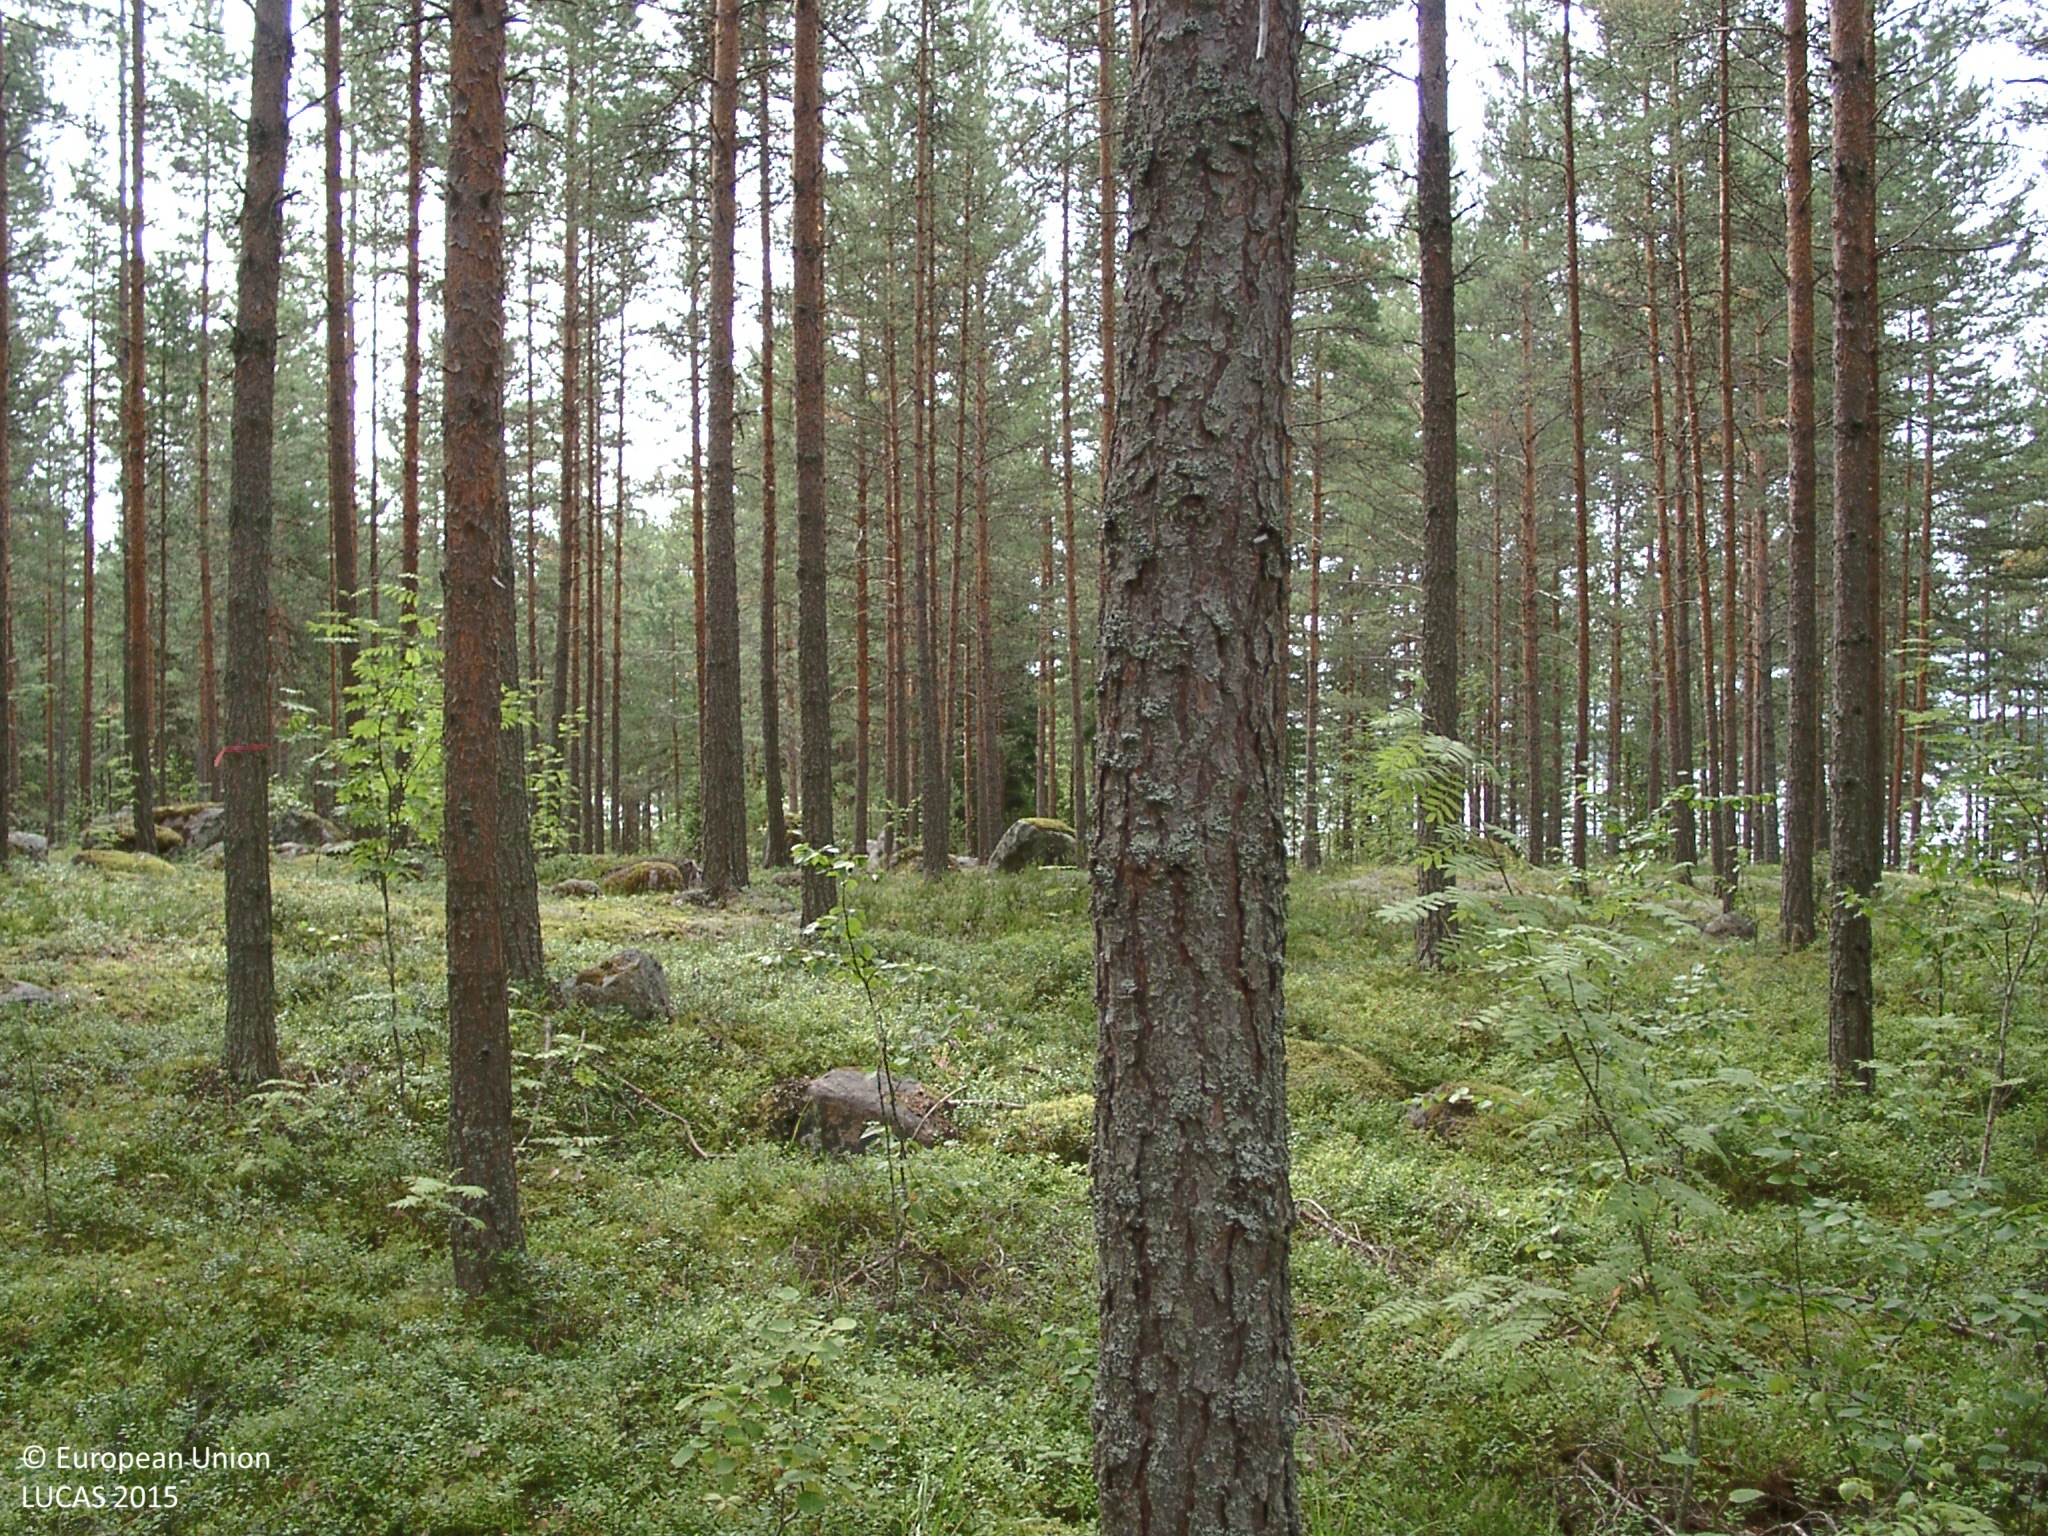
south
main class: Woodland
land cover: Pine dominated coniferous woodland
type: boreal forest
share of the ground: 50 - 75 %
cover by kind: coniferous forest trees 65 %, shrubs 20 %, lichens and mosses 10 %, broadleaved forest trees 5 %
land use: Forestry
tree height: > 5 m
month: August
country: FI
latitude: 61.8078
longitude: 25.2735
